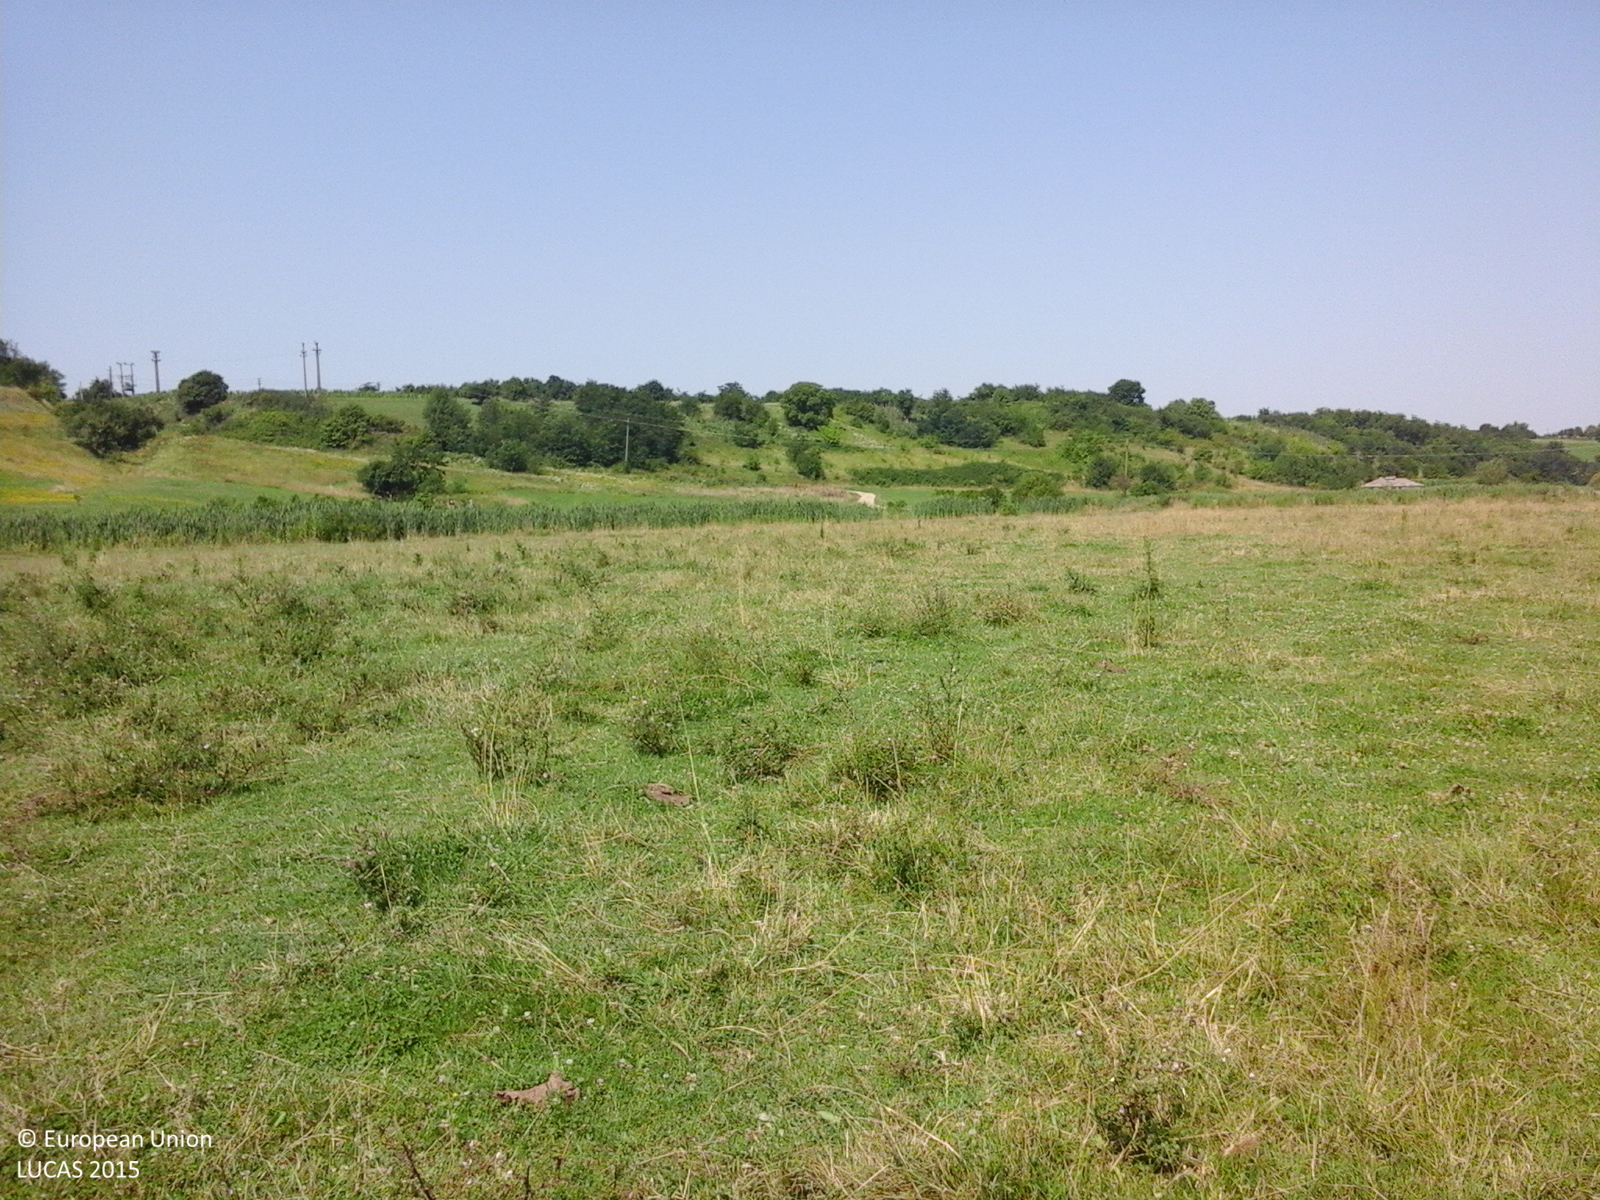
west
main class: Grassland
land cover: Grassland without tree/shrub cover
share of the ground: > 75 %
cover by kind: herbaceous plants 100 %
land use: Agriculture (excluding fallow land and kitchen gardens)
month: July
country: RO
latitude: 44.5396
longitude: 24.9694
